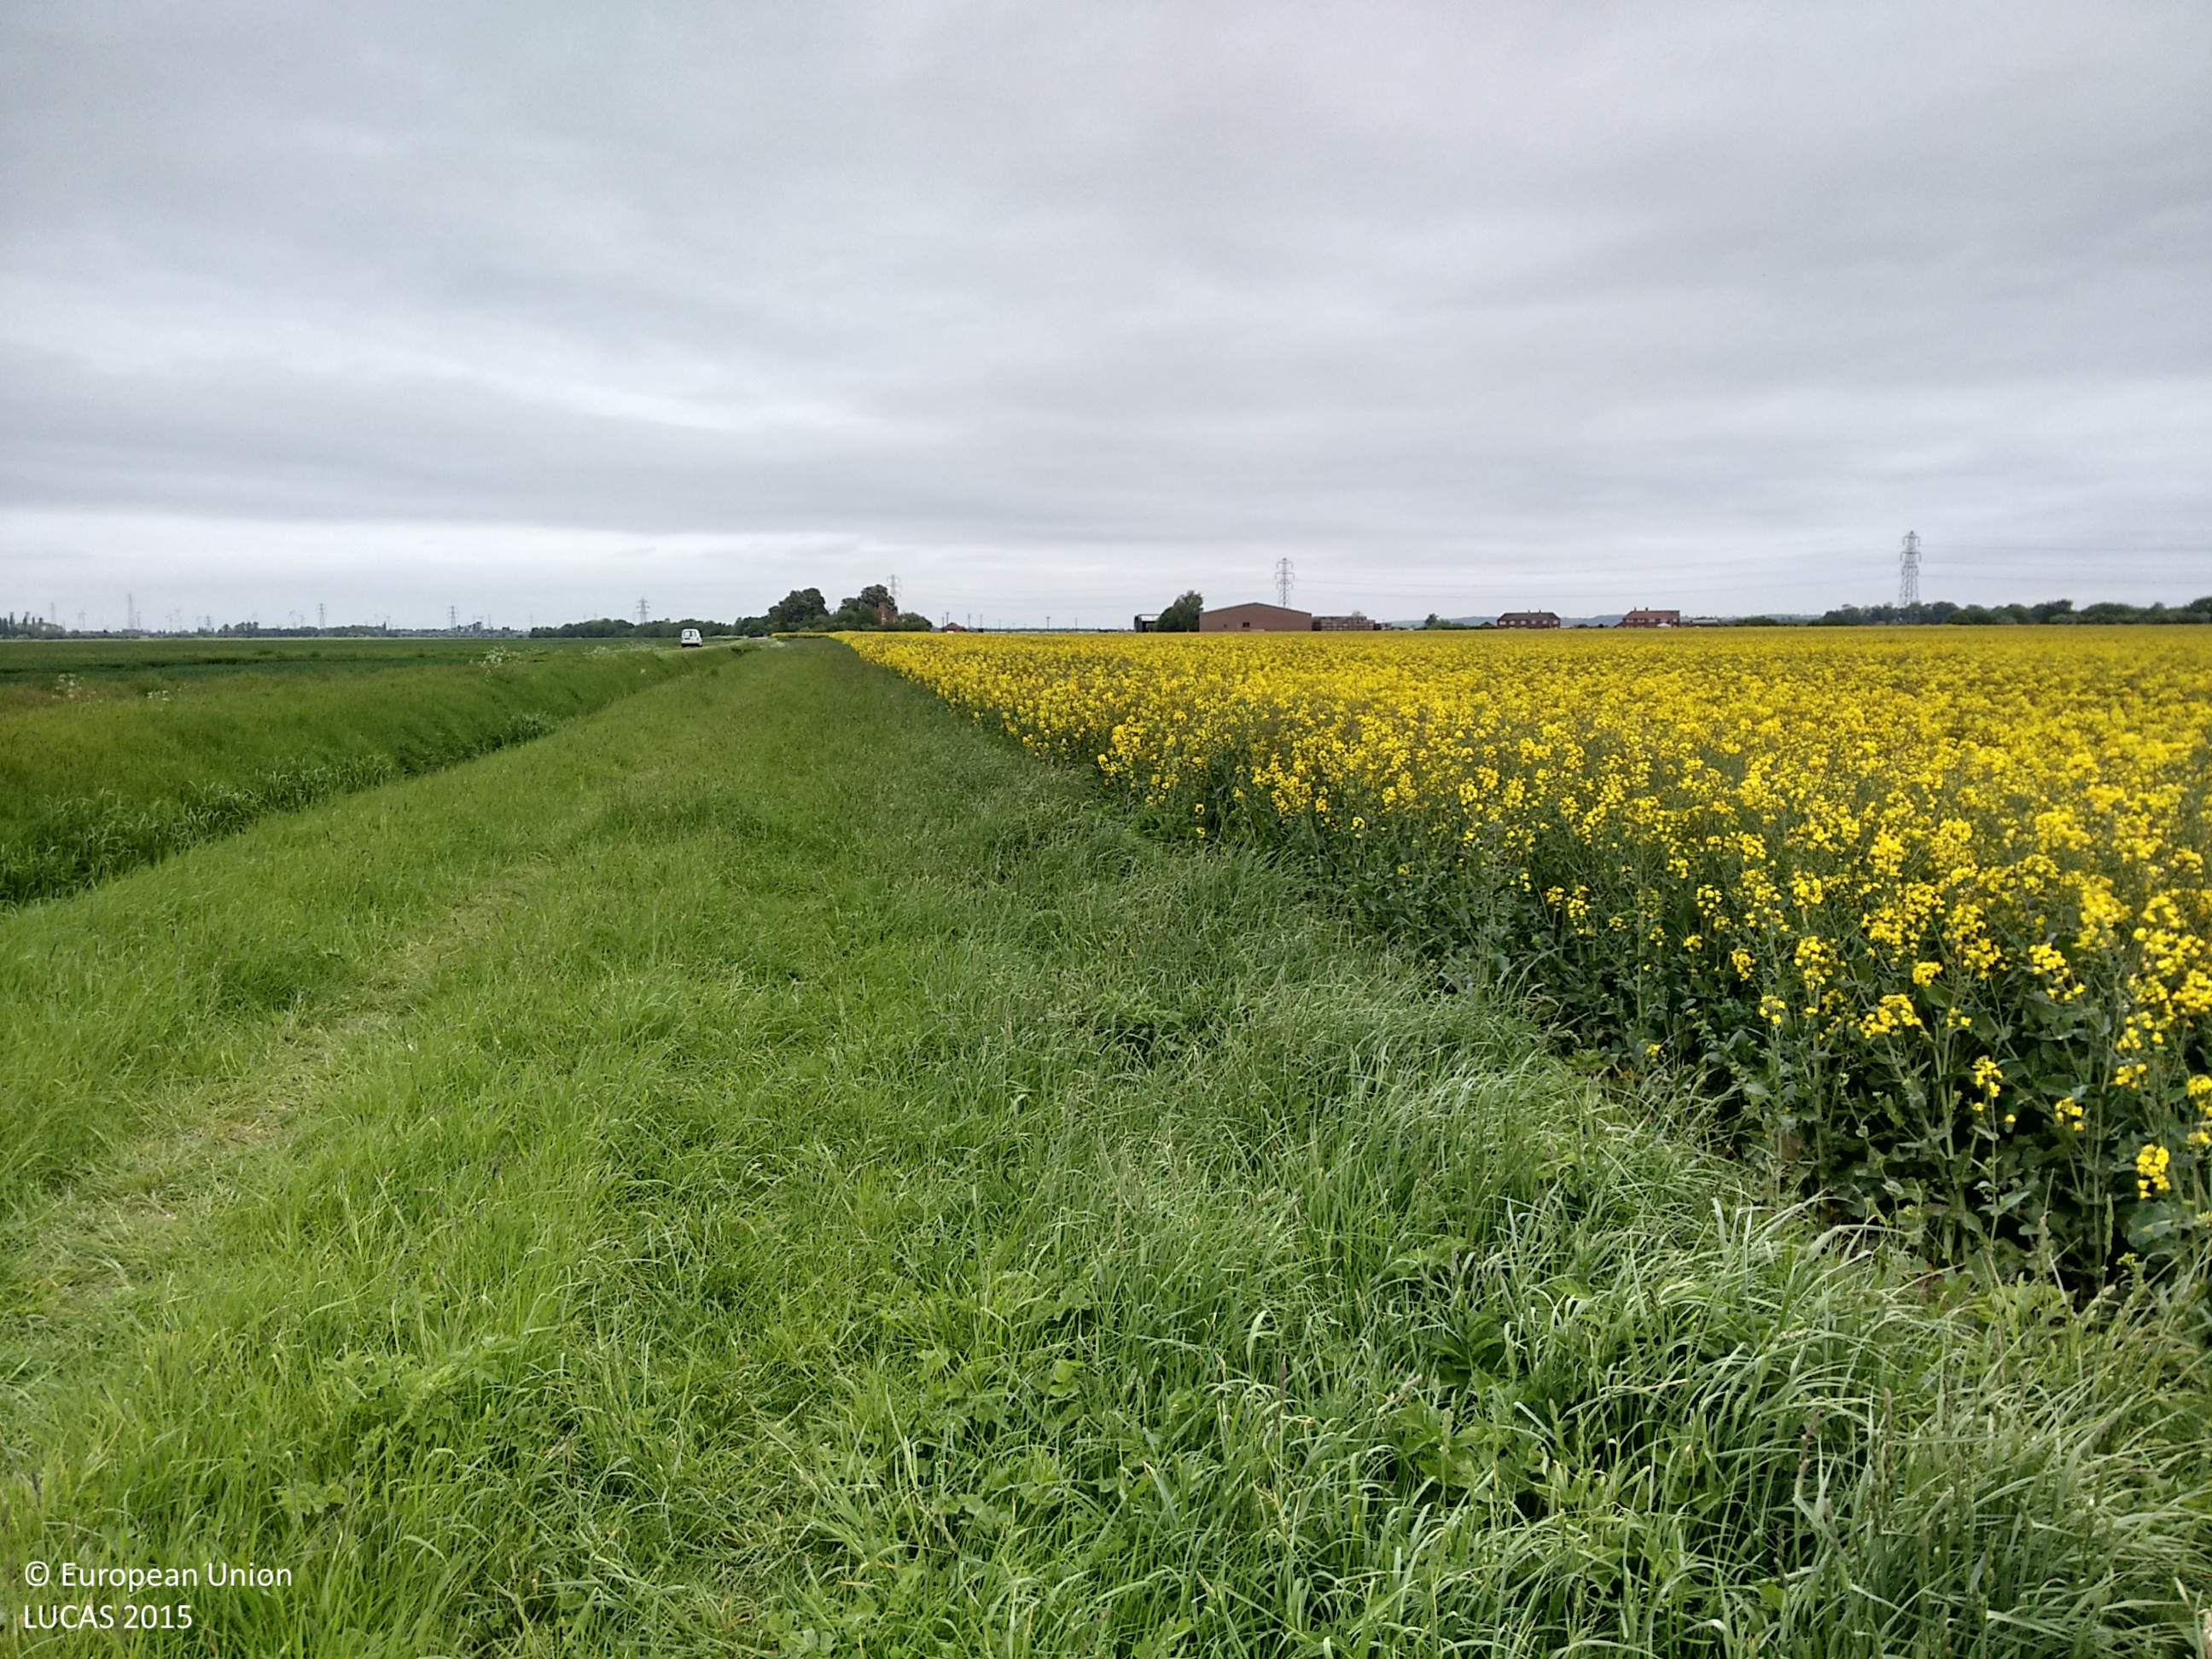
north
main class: Cropland
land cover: Rape and turnip rape
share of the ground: > 75 %
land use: Agriculture (excluding fallow land and kitchen gardens)
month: May
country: GB
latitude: 53.5602
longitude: -0.7132
